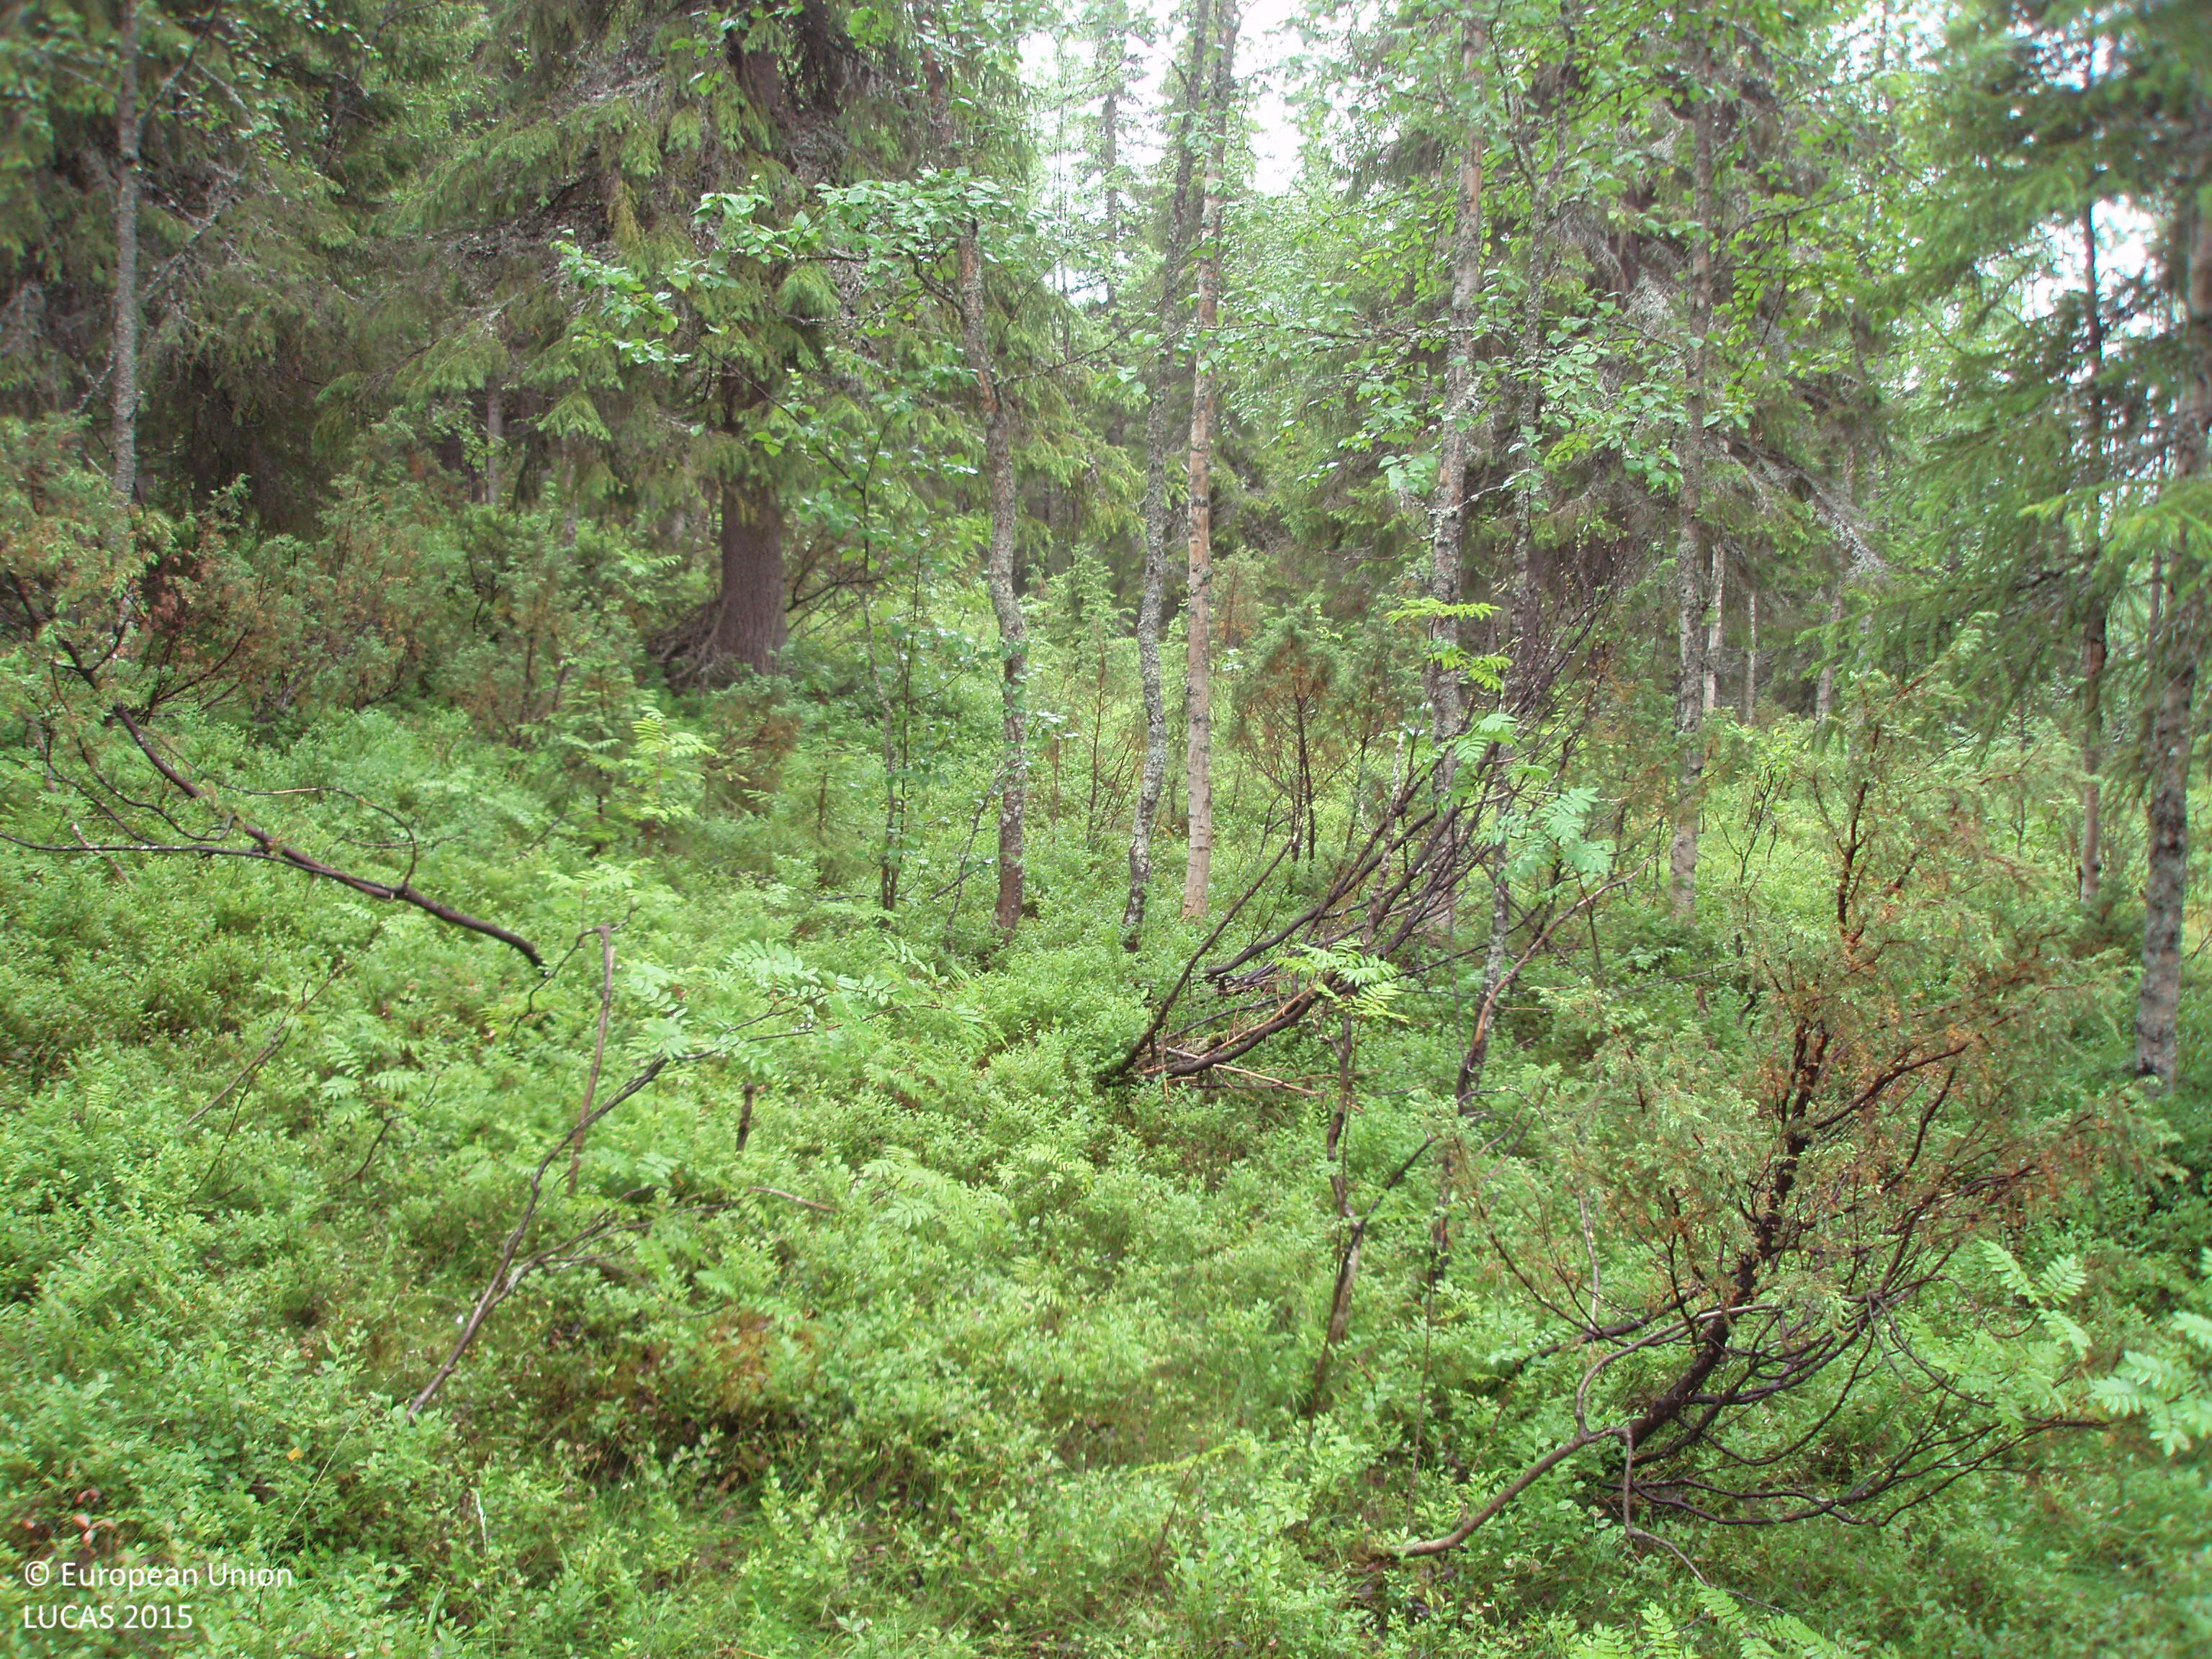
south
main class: Woodland
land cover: Spruce dominated mixed woodland
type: boreal forest
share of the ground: > 75 %
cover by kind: coniferous forest trees 40 %, broadleaved forest trees 35 %, shrubs 25 %
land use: Forestry
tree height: > 5 m
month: August
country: FI
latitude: 65.6310
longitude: 27.6603
